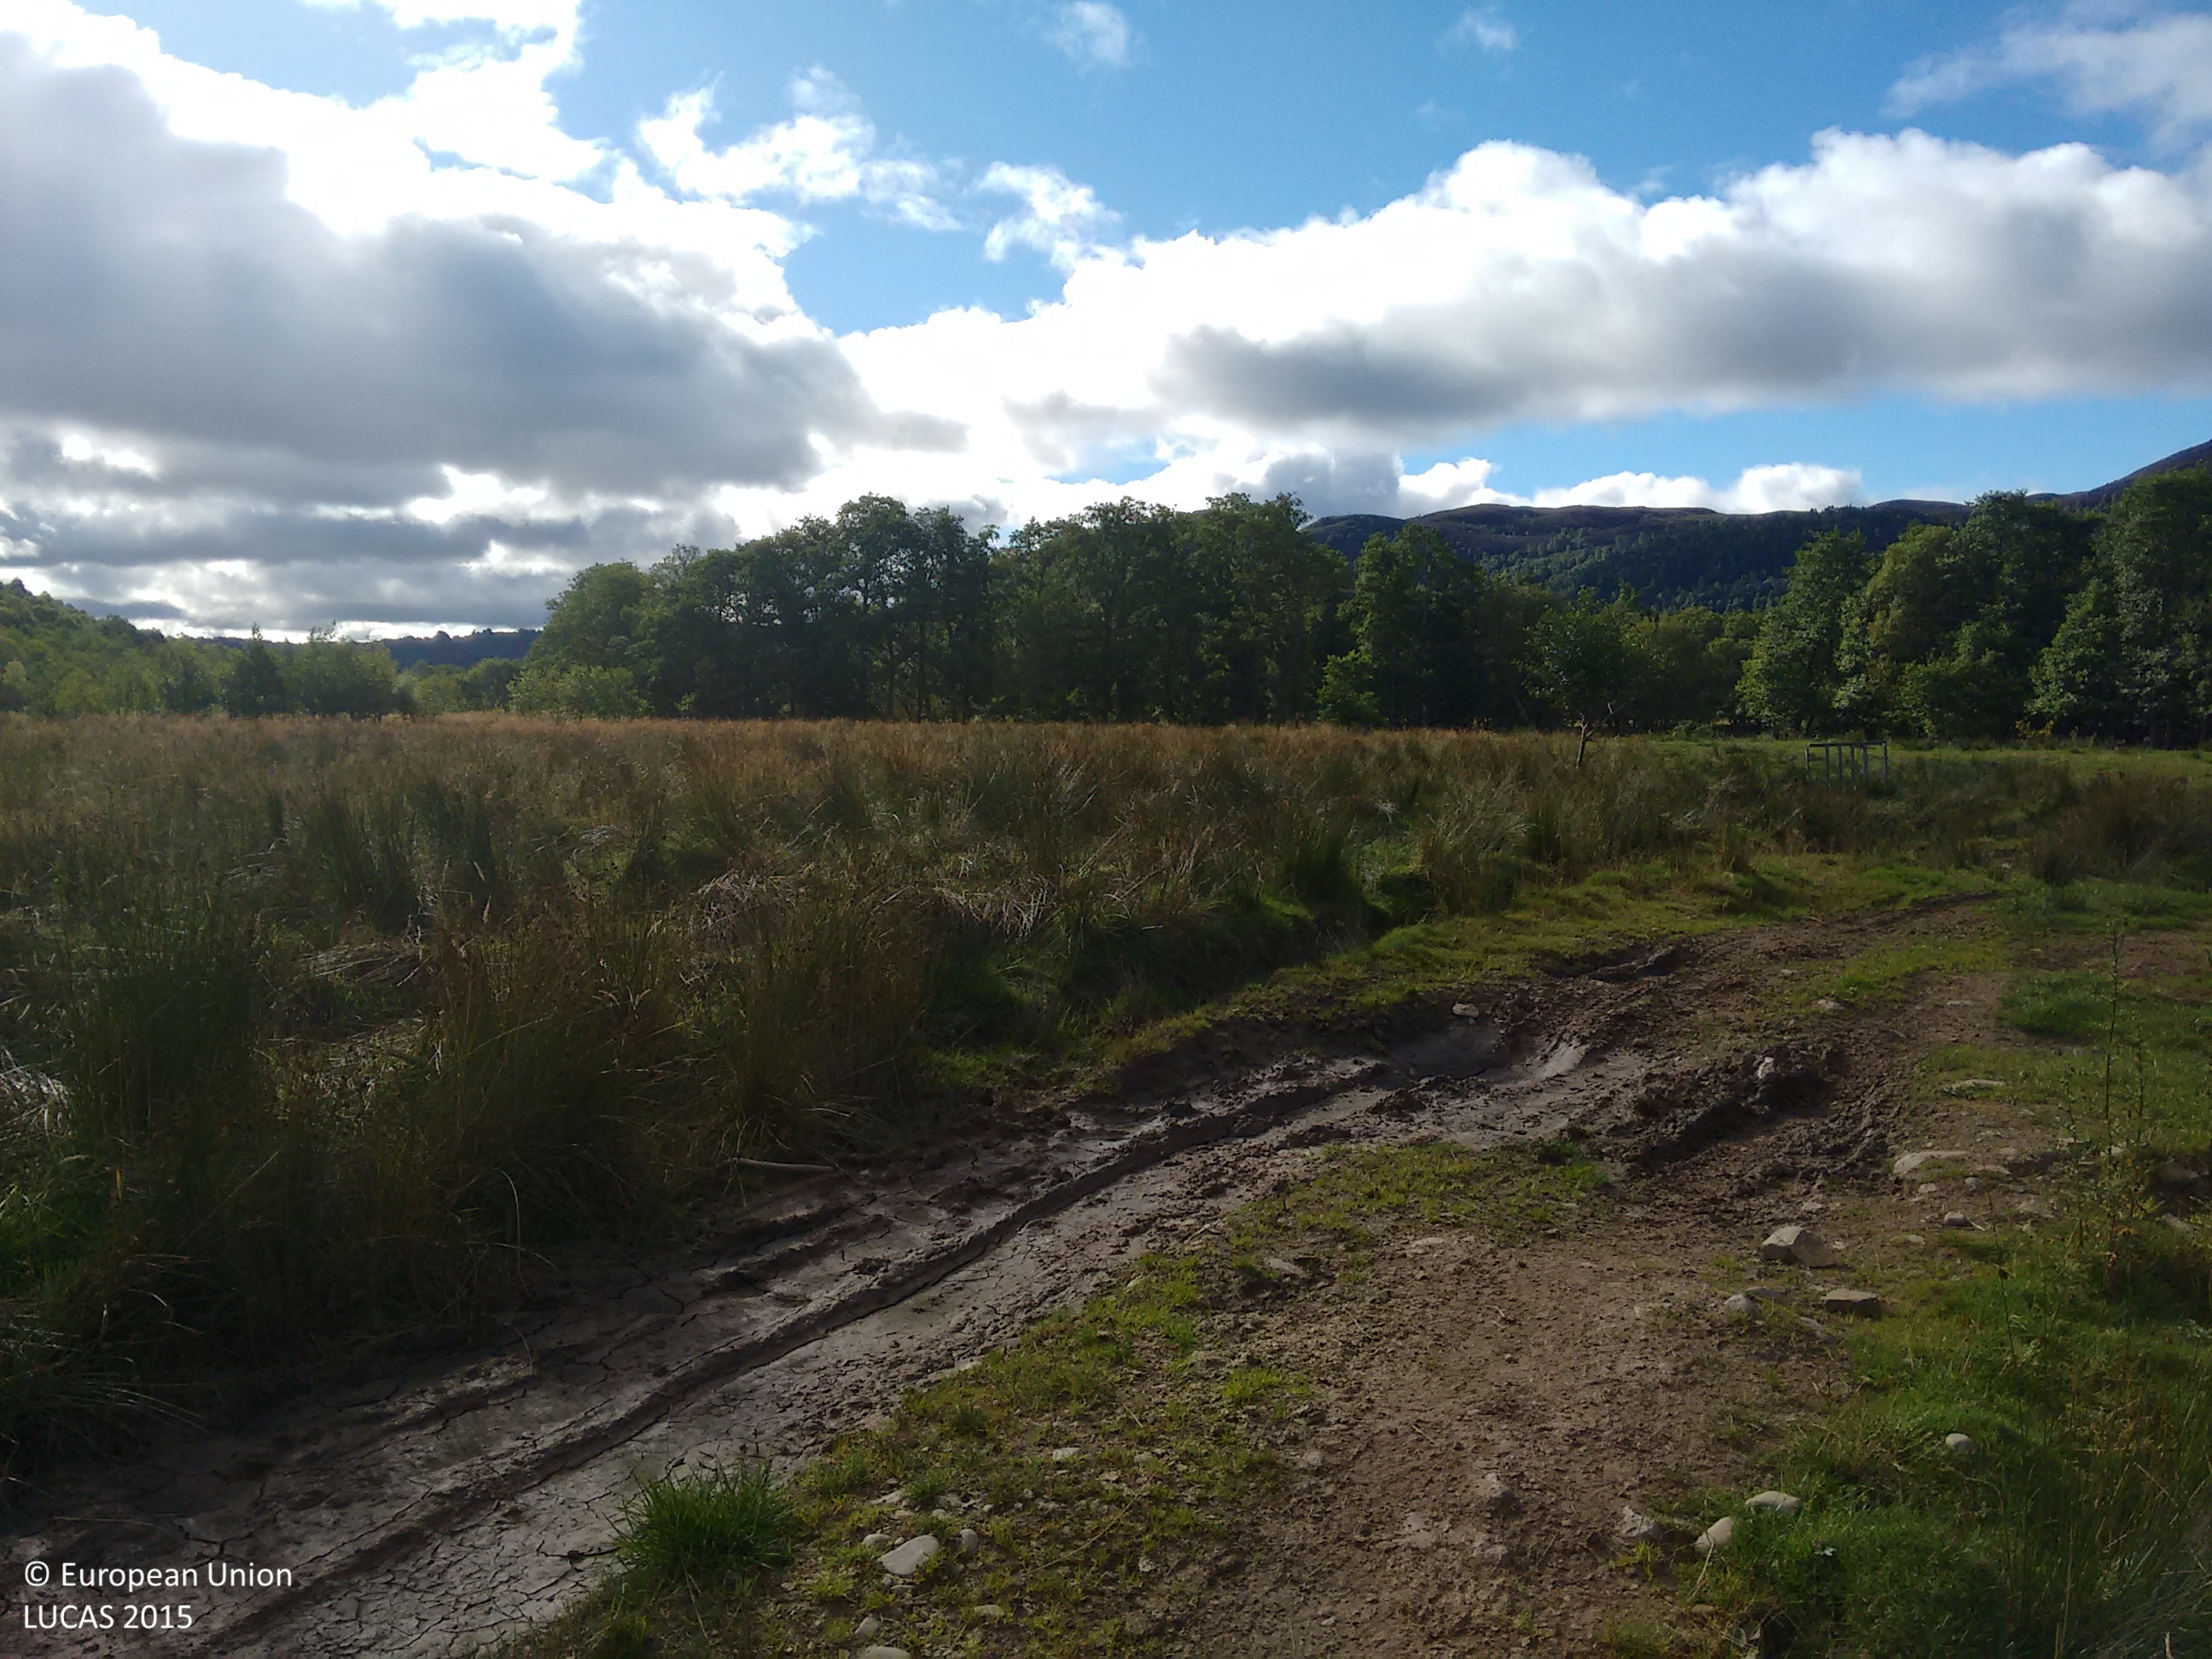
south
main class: Woodland
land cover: Broadleaved woodland
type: floodplain forest
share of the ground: > 75 %
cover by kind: broadleaved forest trees 100 %
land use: Semi-natural and natural areas not in use
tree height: > 5 m
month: September
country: GB
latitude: 57.6095
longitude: -4.6726
